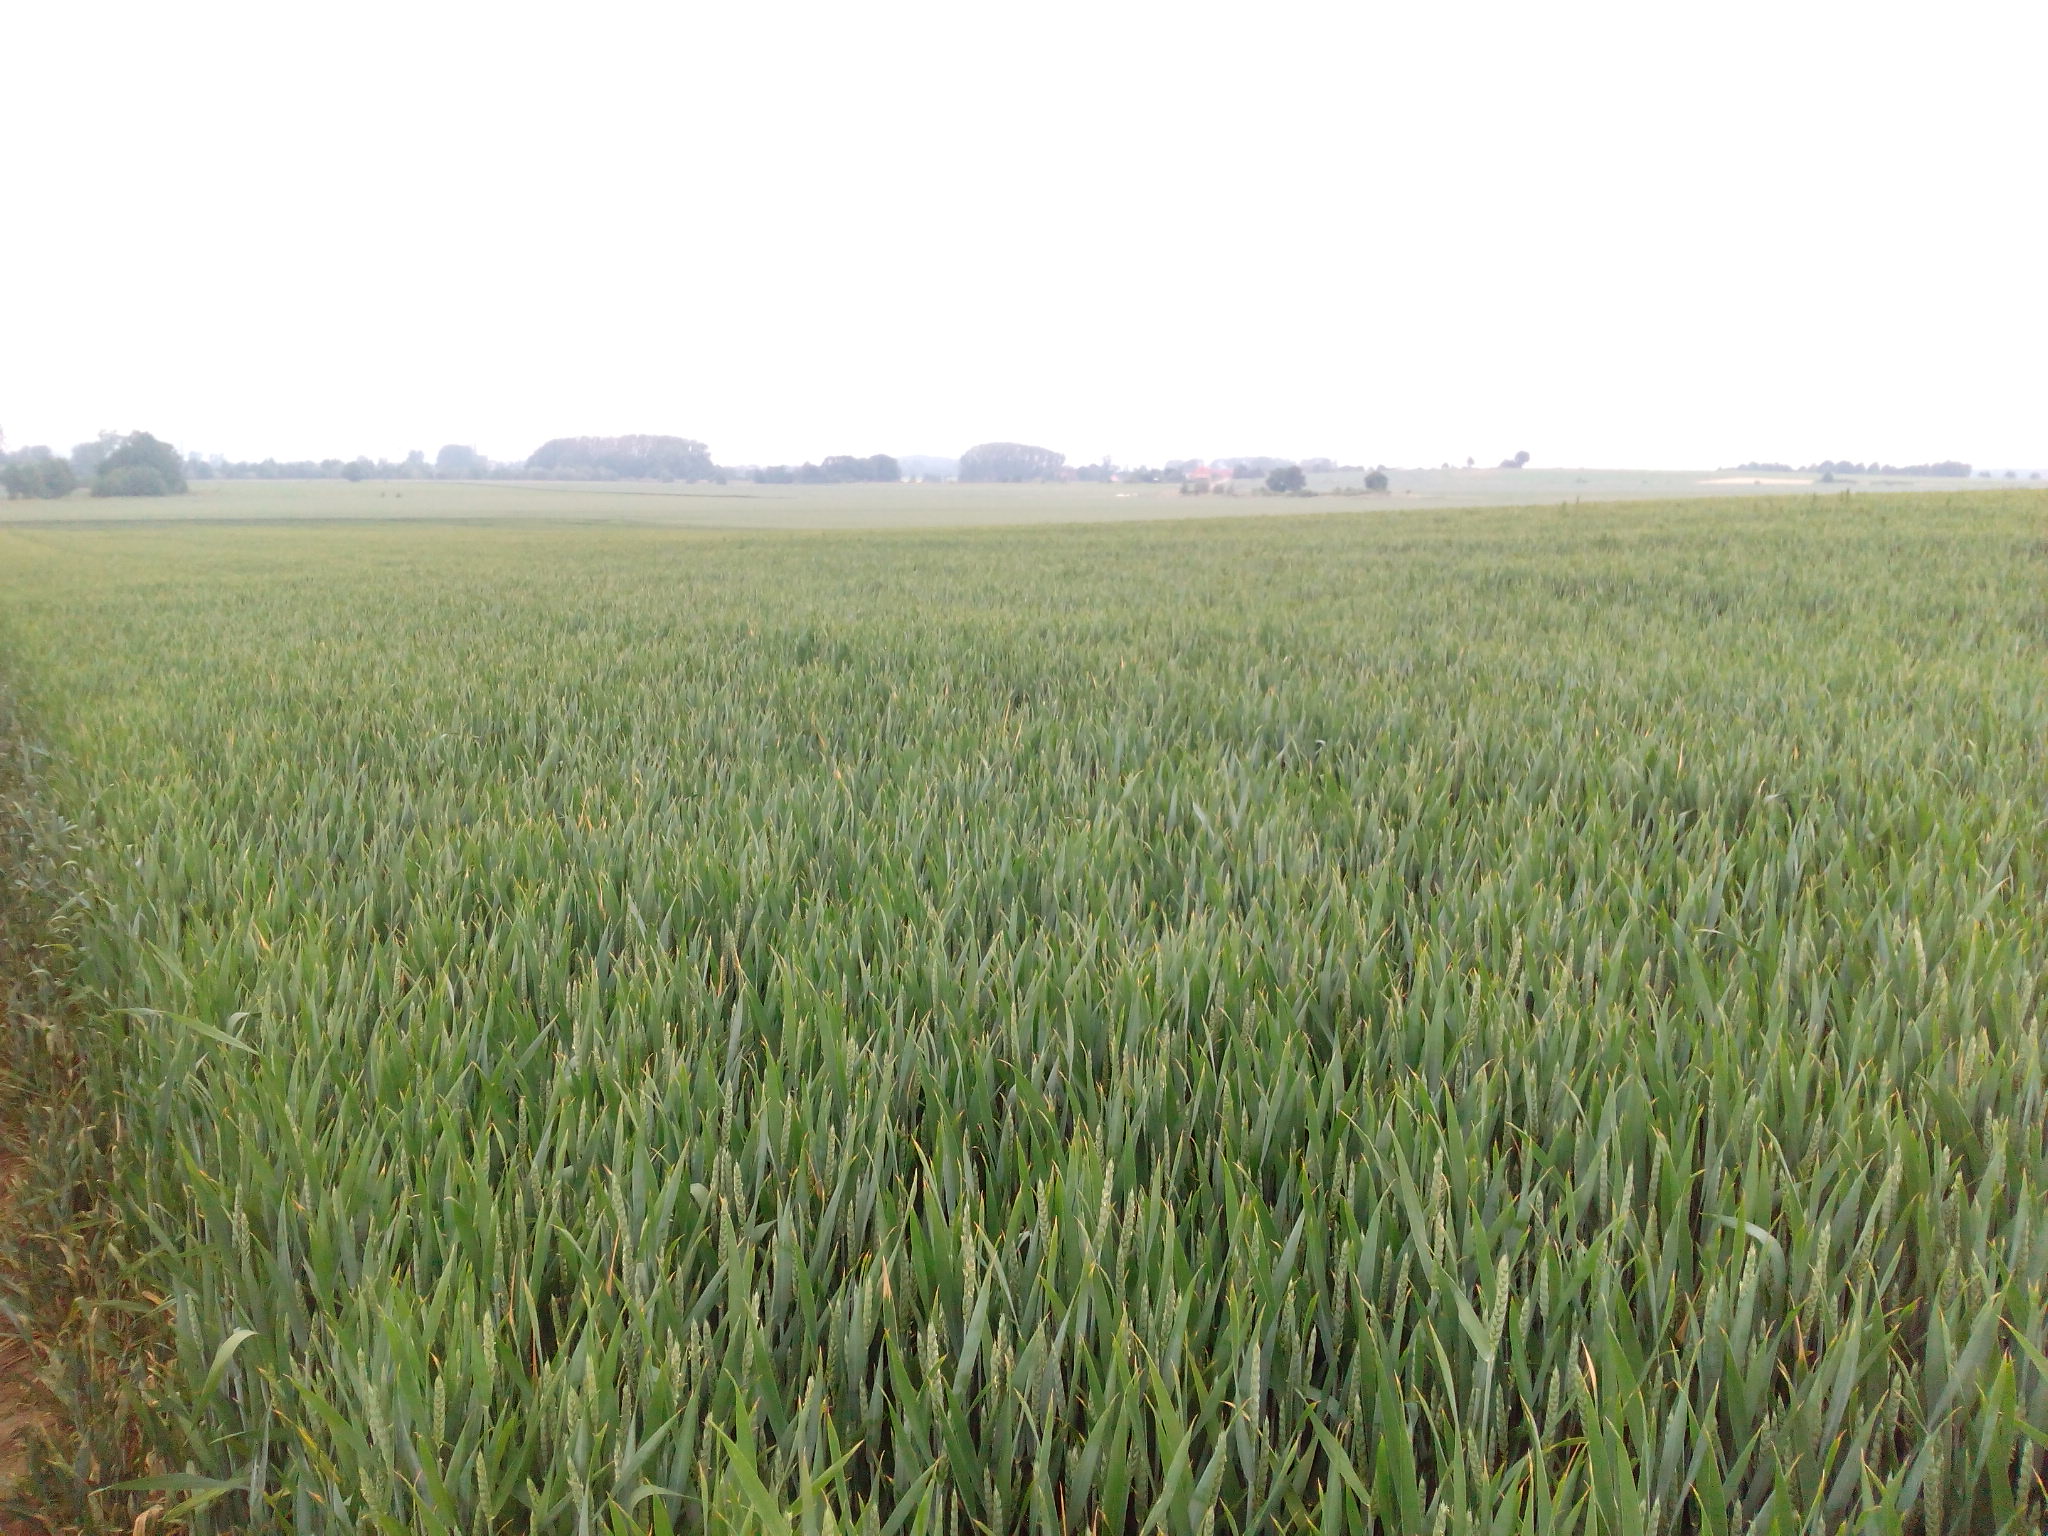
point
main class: Cropland
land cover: Common wheat
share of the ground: > 75 %
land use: Agriculture (excluding fallow land and kitchen gardens)
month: June
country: DE
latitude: 52.2691
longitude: 9.6338
